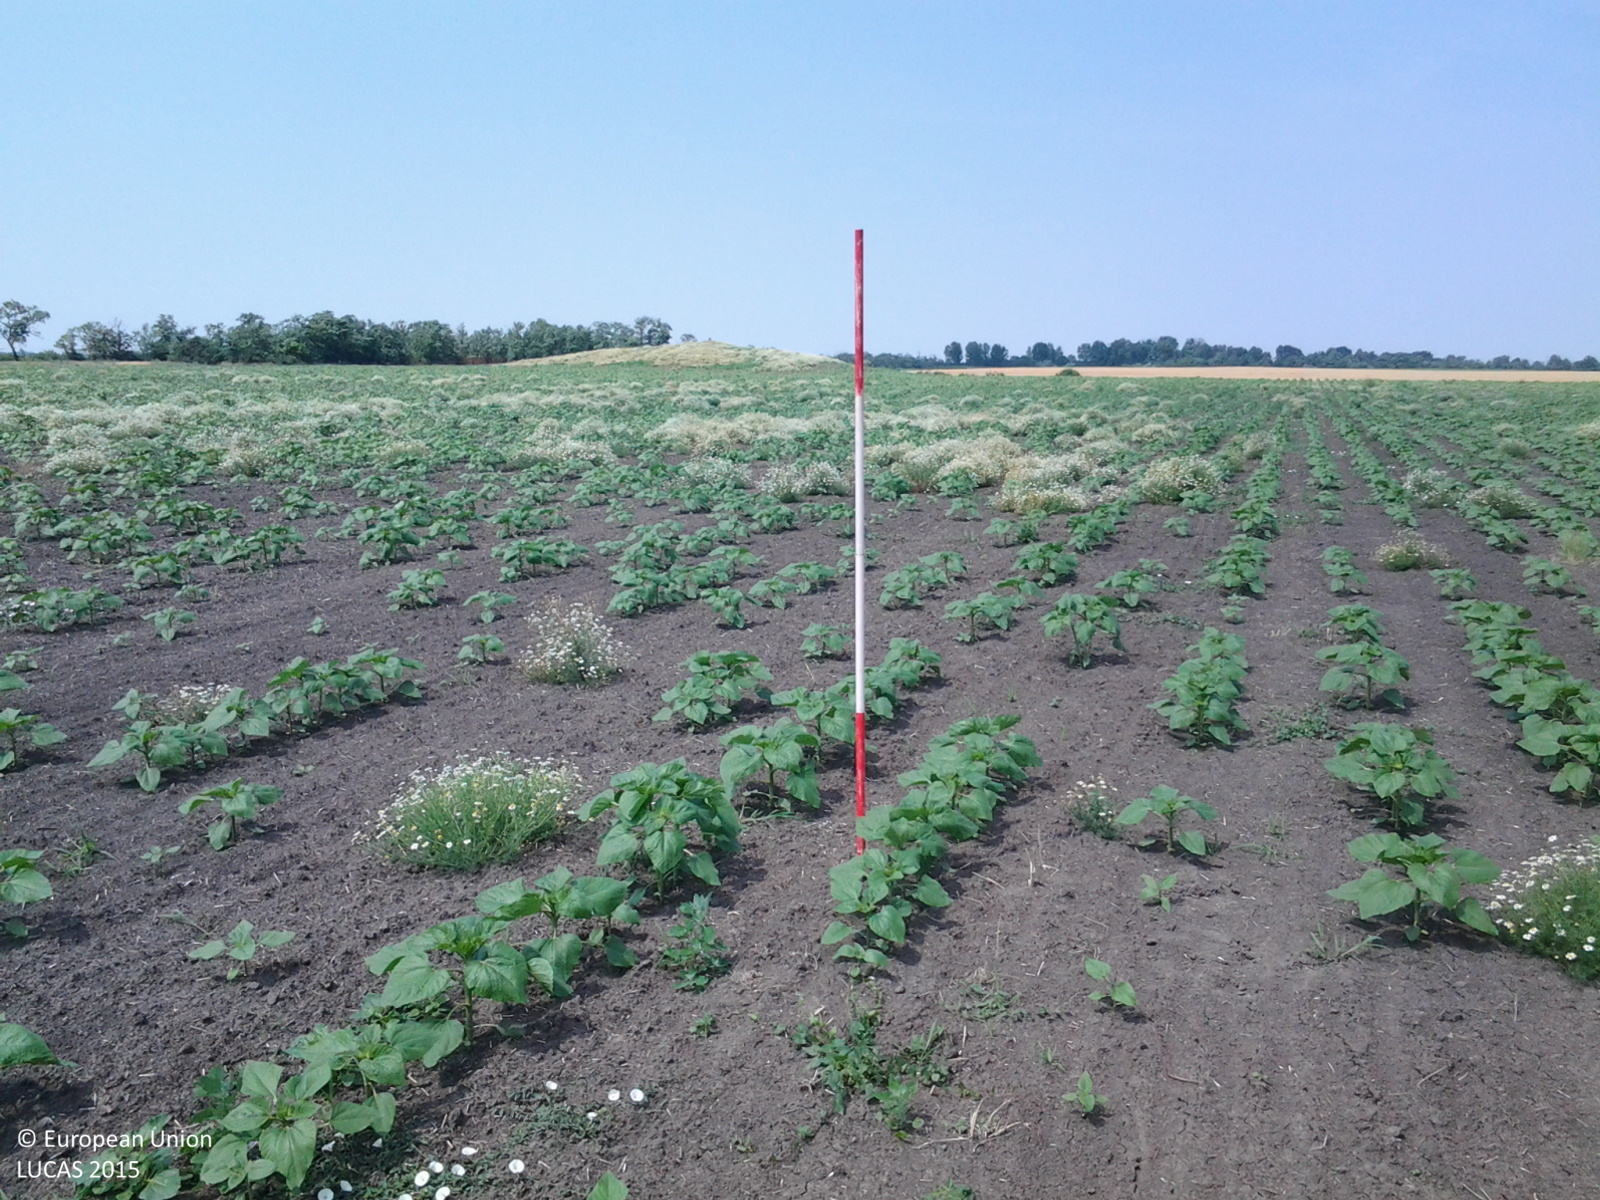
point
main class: Cropland
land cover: Sunflower
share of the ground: 25 - 50 %
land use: Agriculture (excluding fallow land and kitchen gardens)
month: July
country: HU
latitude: 46.9761
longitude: 20.5056
